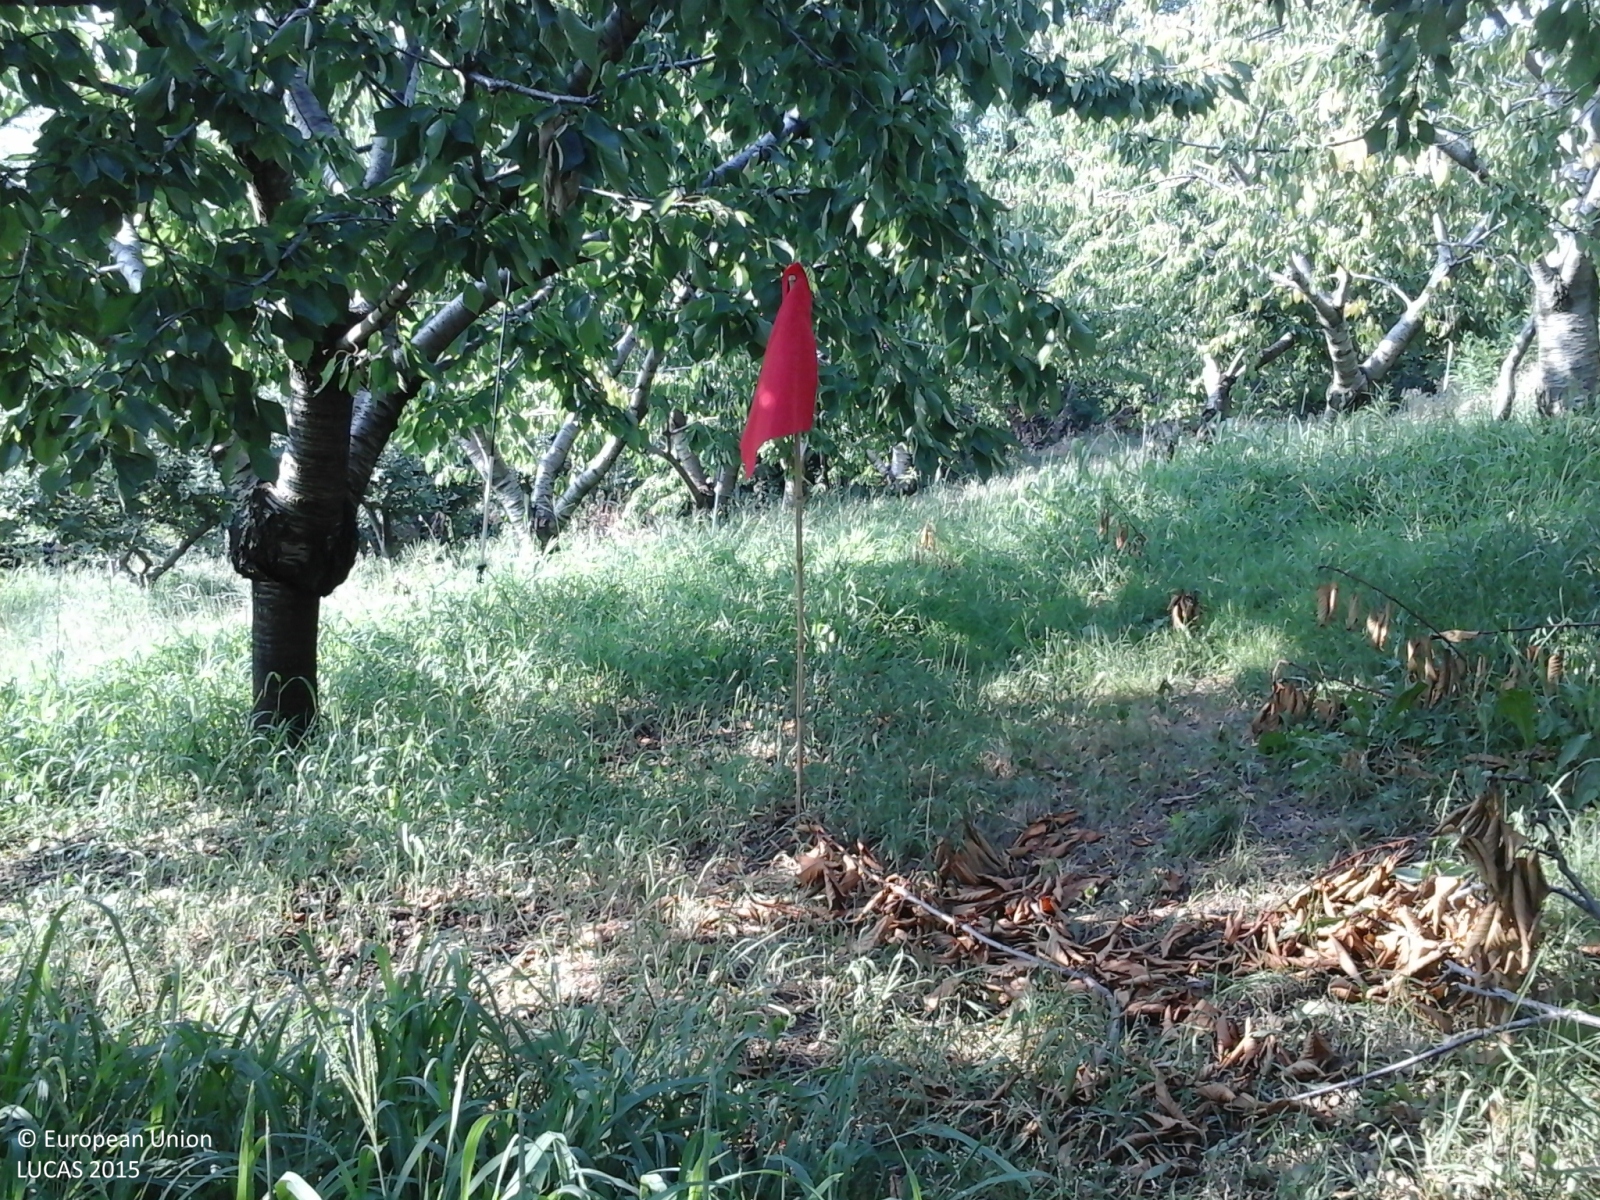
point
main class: Cropland
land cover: Cherry fruit
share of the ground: > 75 %
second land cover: Grassland without tree/shrub cover
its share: > 75 %
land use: Agriculture (excluding fallow land and kitchen gardens)
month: July
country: IT
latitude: 45.5512
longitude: 11.2404
